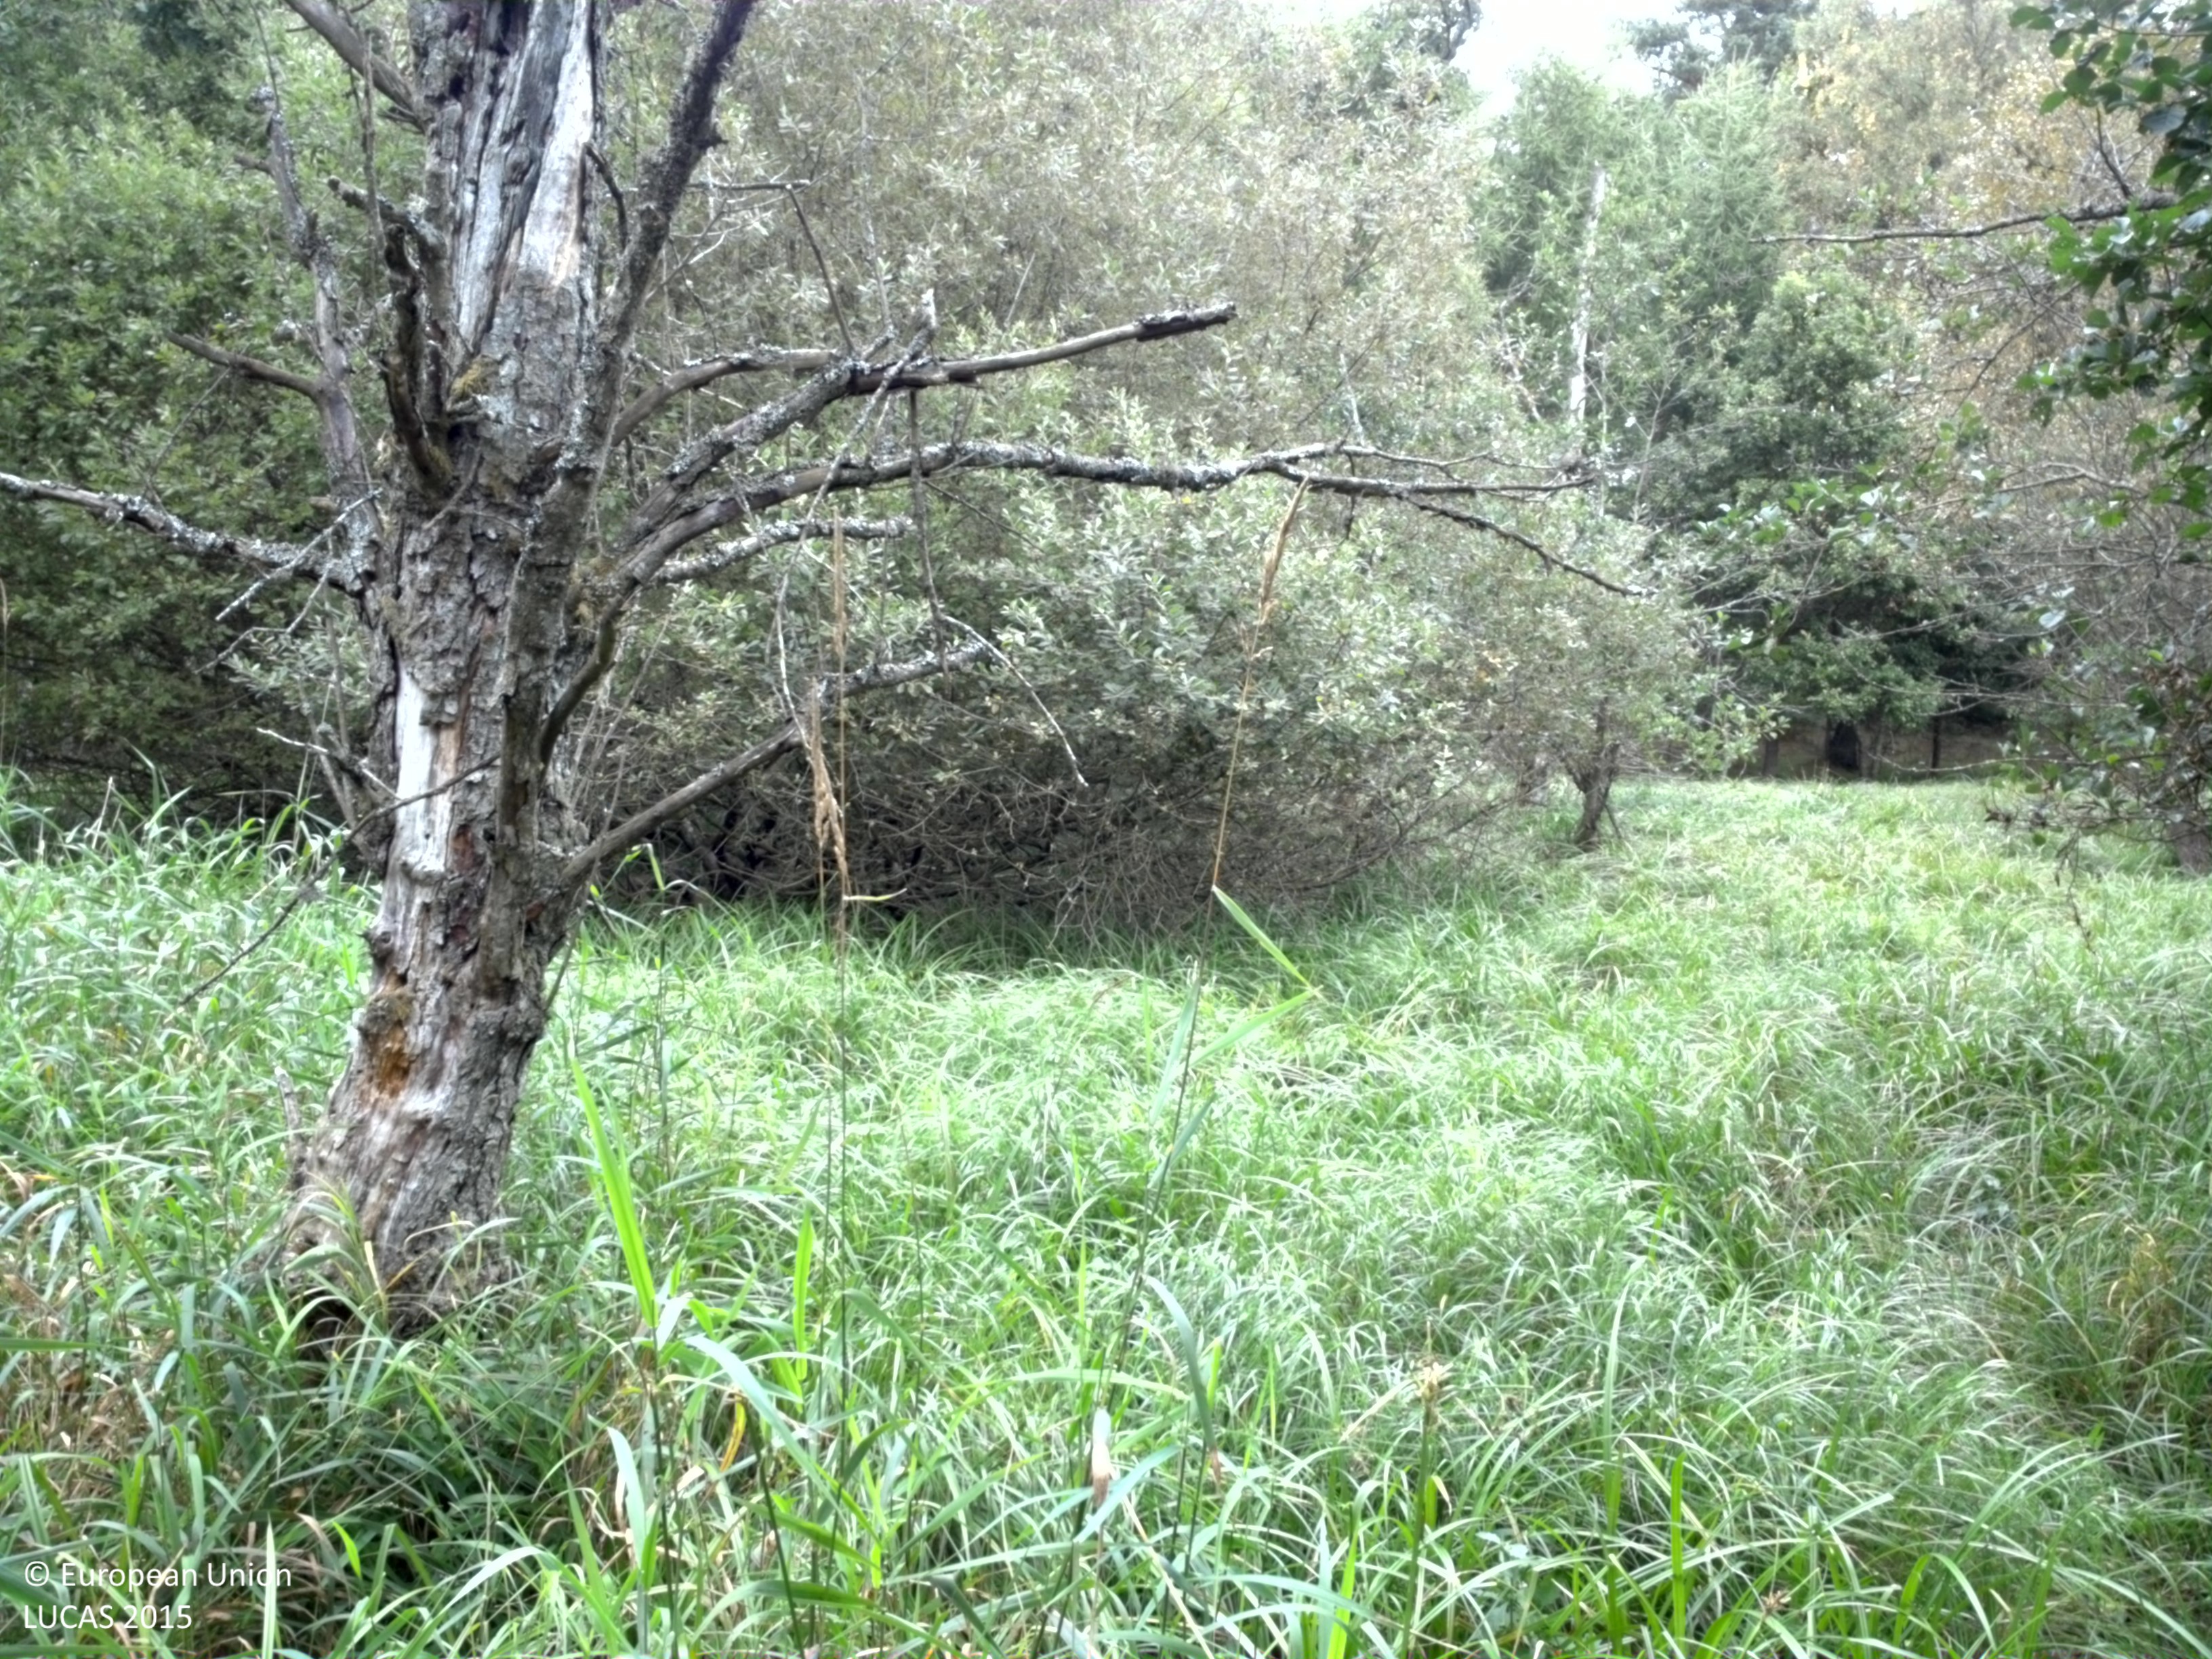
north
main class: Woodland
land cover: Broadleaved woodland
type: mesophytic deciduous forest
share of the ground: 25 - 50 %
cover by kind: herbaceous plants 50 %, broadleaved forest trees 40 %, shrubs 10 %
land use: Forestry
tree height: < 5 m
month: September
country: SE
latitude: 55.5409
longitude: 13.6906
